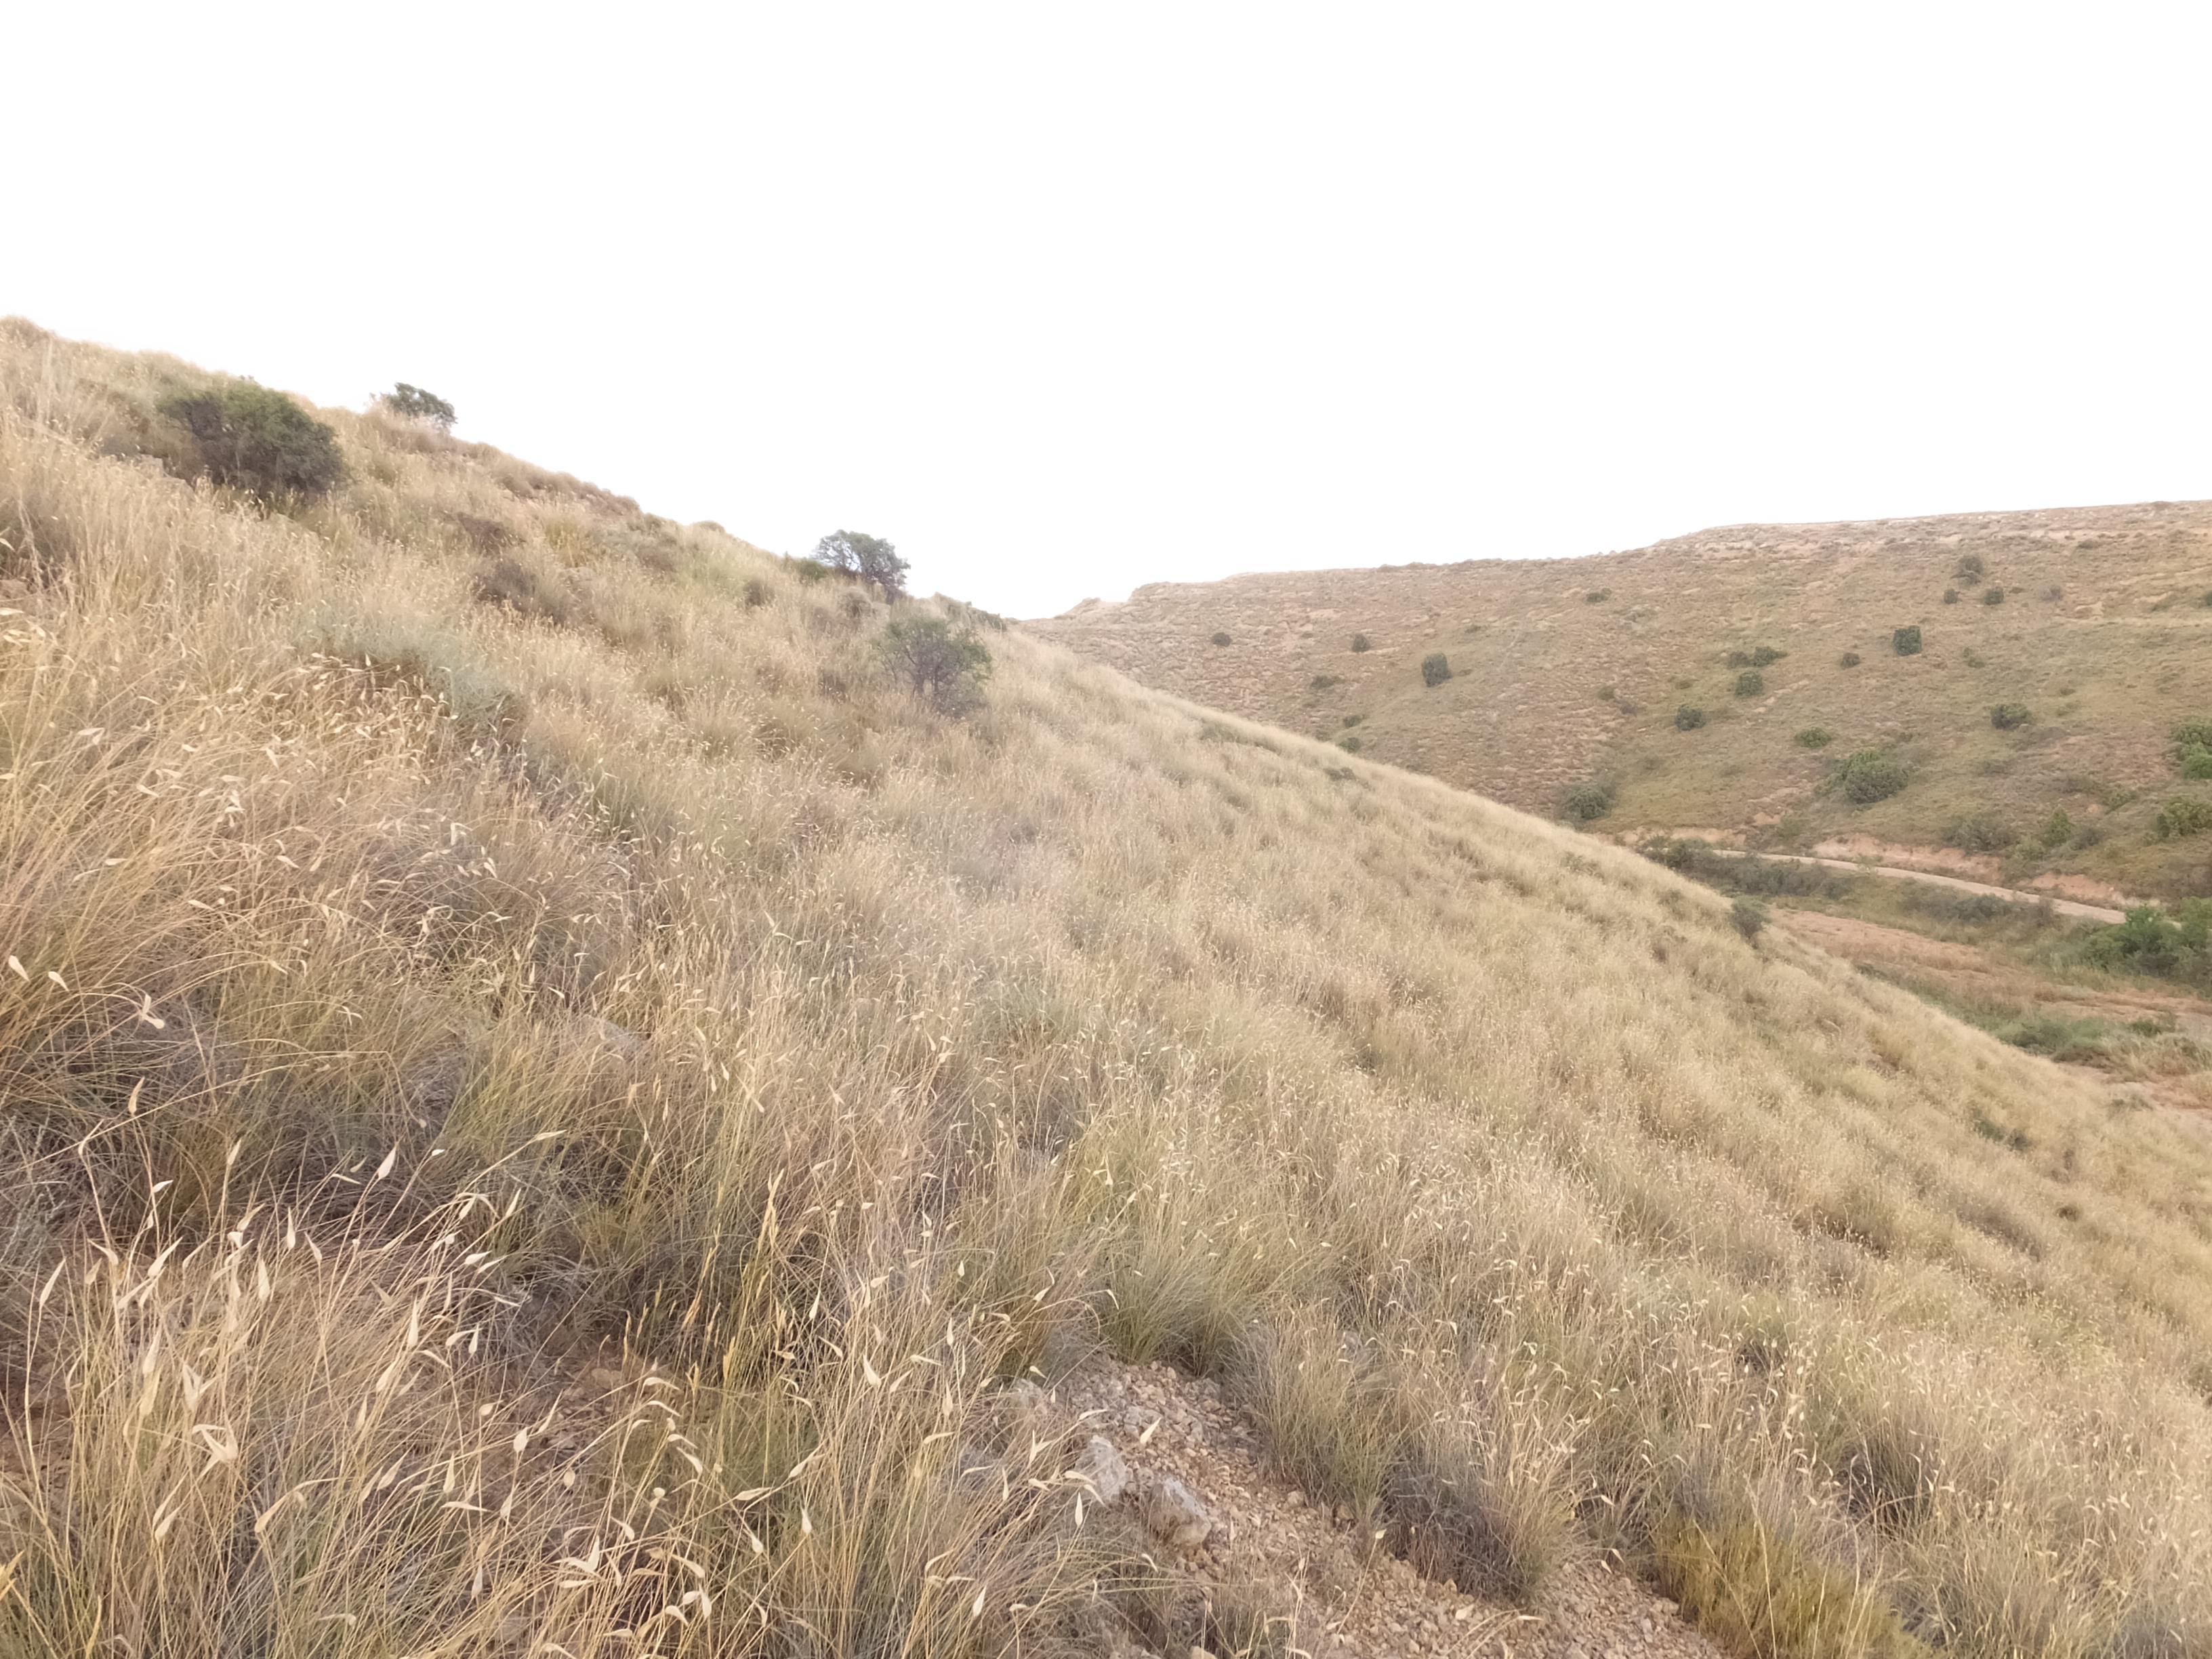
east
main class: Shrubland
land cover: Shrubland without tree cover
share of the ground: 50 - 75 %
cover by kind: shrubs 50 %, herbaceous plants 40 %, consolidated bare surface 10 %
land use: Semi-natural and natural areas not in use
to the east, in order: Shrubland without tree cover; Rock outcrops; Shrubland without tree cover; Barley; Shruby margins; Tracks; Shrubland with sparse tree cover; Rock outcrops; Shrubland with sparse tree cover
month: June
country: ES
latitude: 41.6696
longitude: 0.0272
